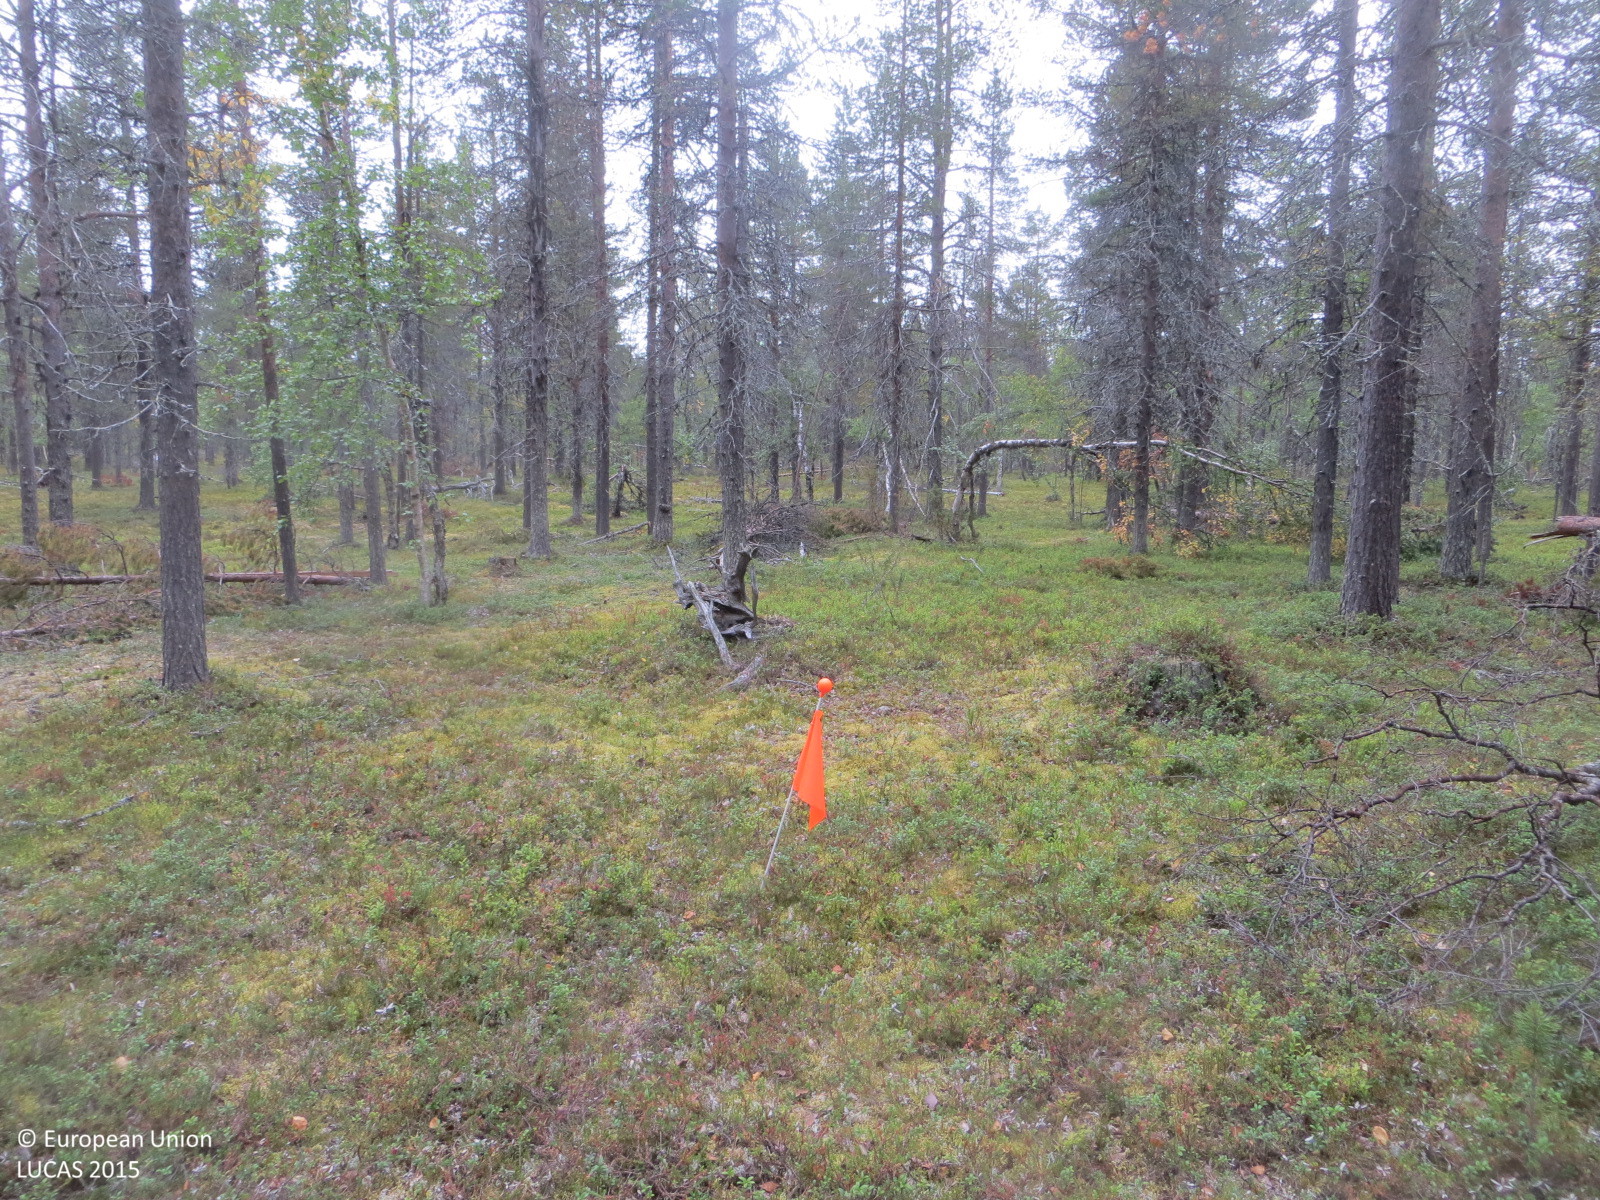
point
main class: Woodland
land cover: Pine dominated coniferous woodland
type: boreal forest
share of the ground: 50 - 75 %
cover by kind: coniferous forest trees 50 %, shrubs 50 %
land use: Forestry
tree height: > 5 m
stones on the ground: 25 - 50 %
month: August
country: FI
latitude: 68.1420
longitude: 25.6135
